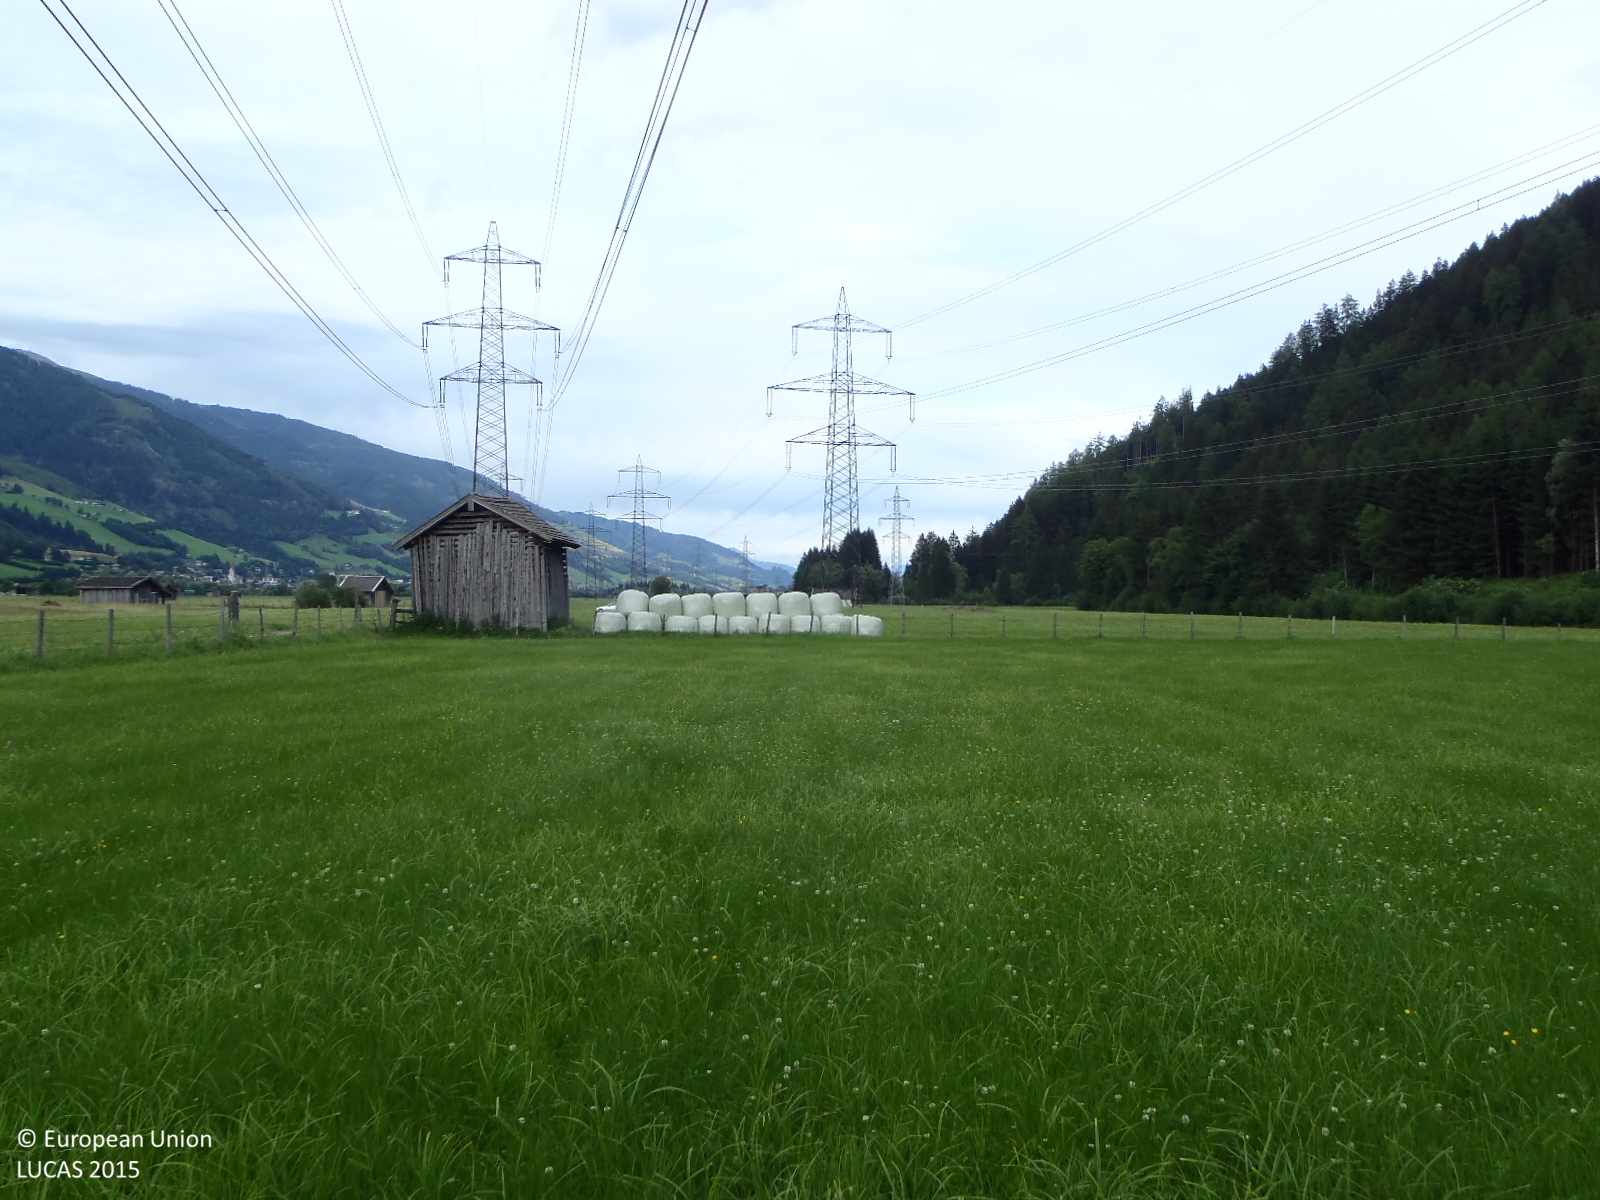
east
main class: Artificial land
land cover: Other artificial areas
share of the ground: > 75 %
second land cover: Grassland without tree/shrub cover
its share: > 75 %
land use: Electricity, gas and thermal power distribution
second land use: Agriculture (excluding fallow land and kitchen gardens)
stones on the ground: < 10 %
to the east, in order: Grassland without tree/shrub cover; Fences; Grassland without tree/shrub cover; Electric lines; Grassland without tree/shrub cover
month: June
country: AT
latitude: 47.2769
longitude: 12.4966
